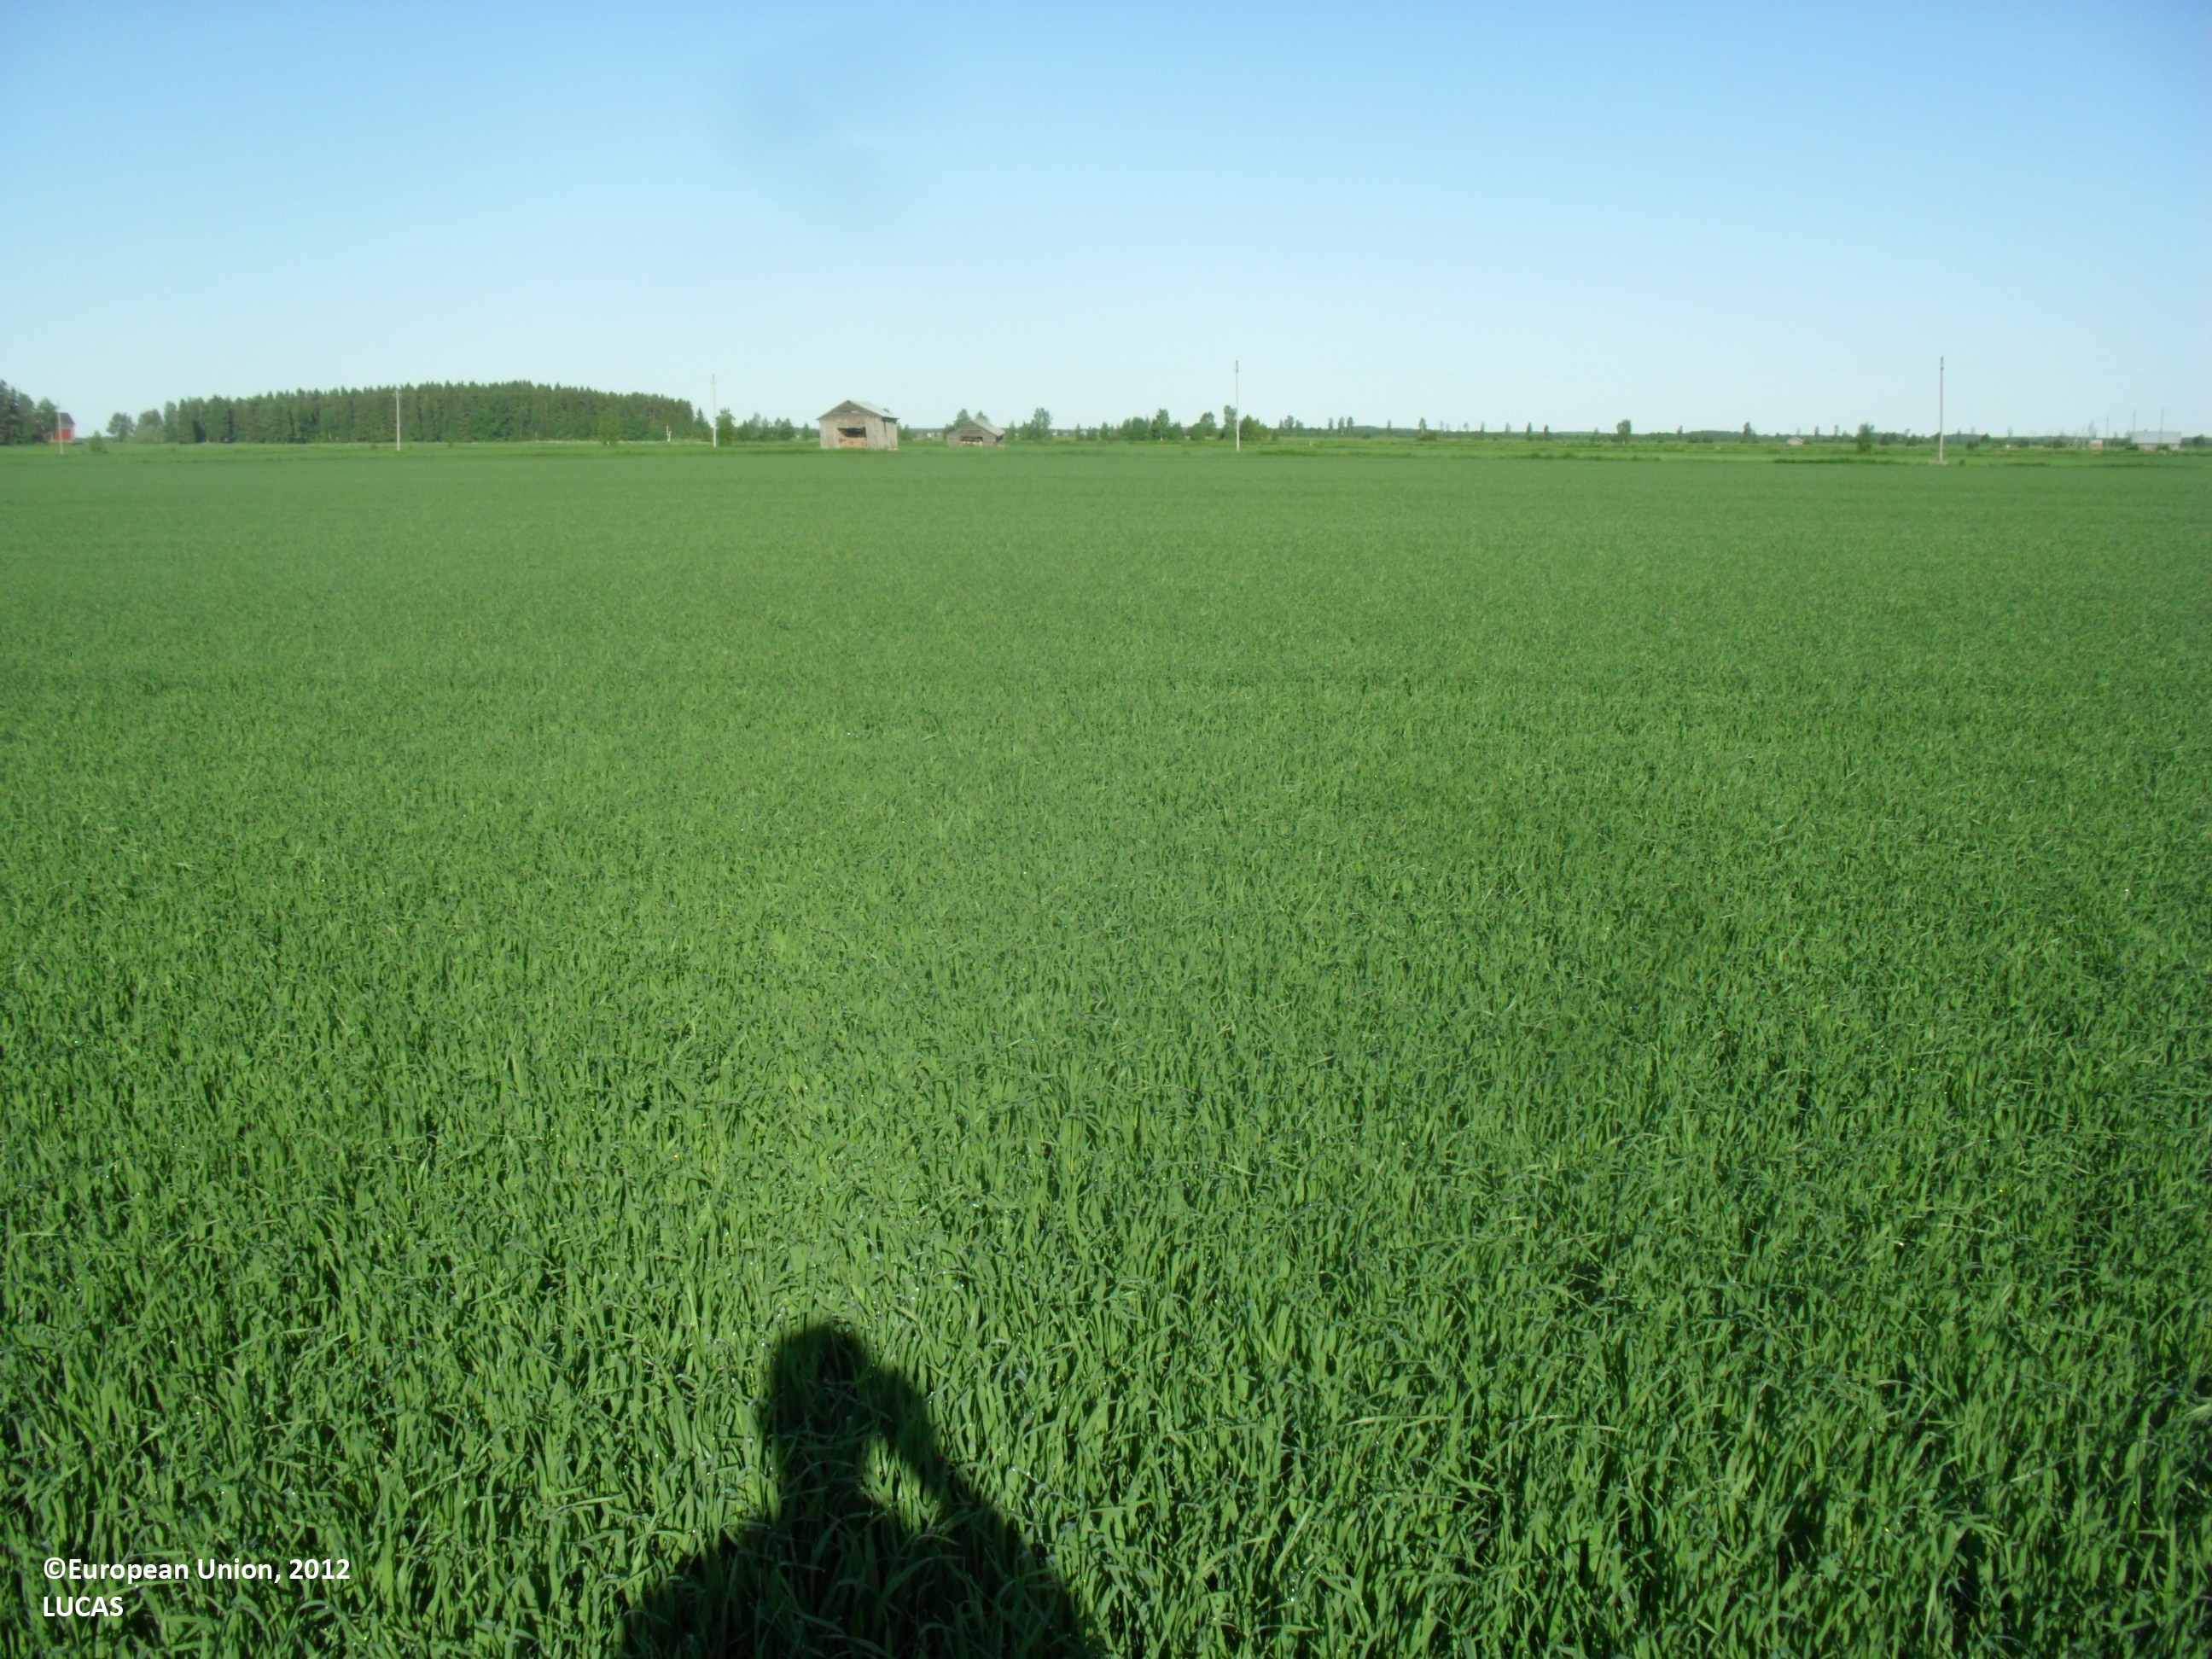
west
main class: Cropland
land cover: Oats
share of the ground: > 75 %
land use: Agriculture (excluding fallow land and kitchen gardens)
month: June
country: FI
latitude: 63.0768
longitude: 22.9442
